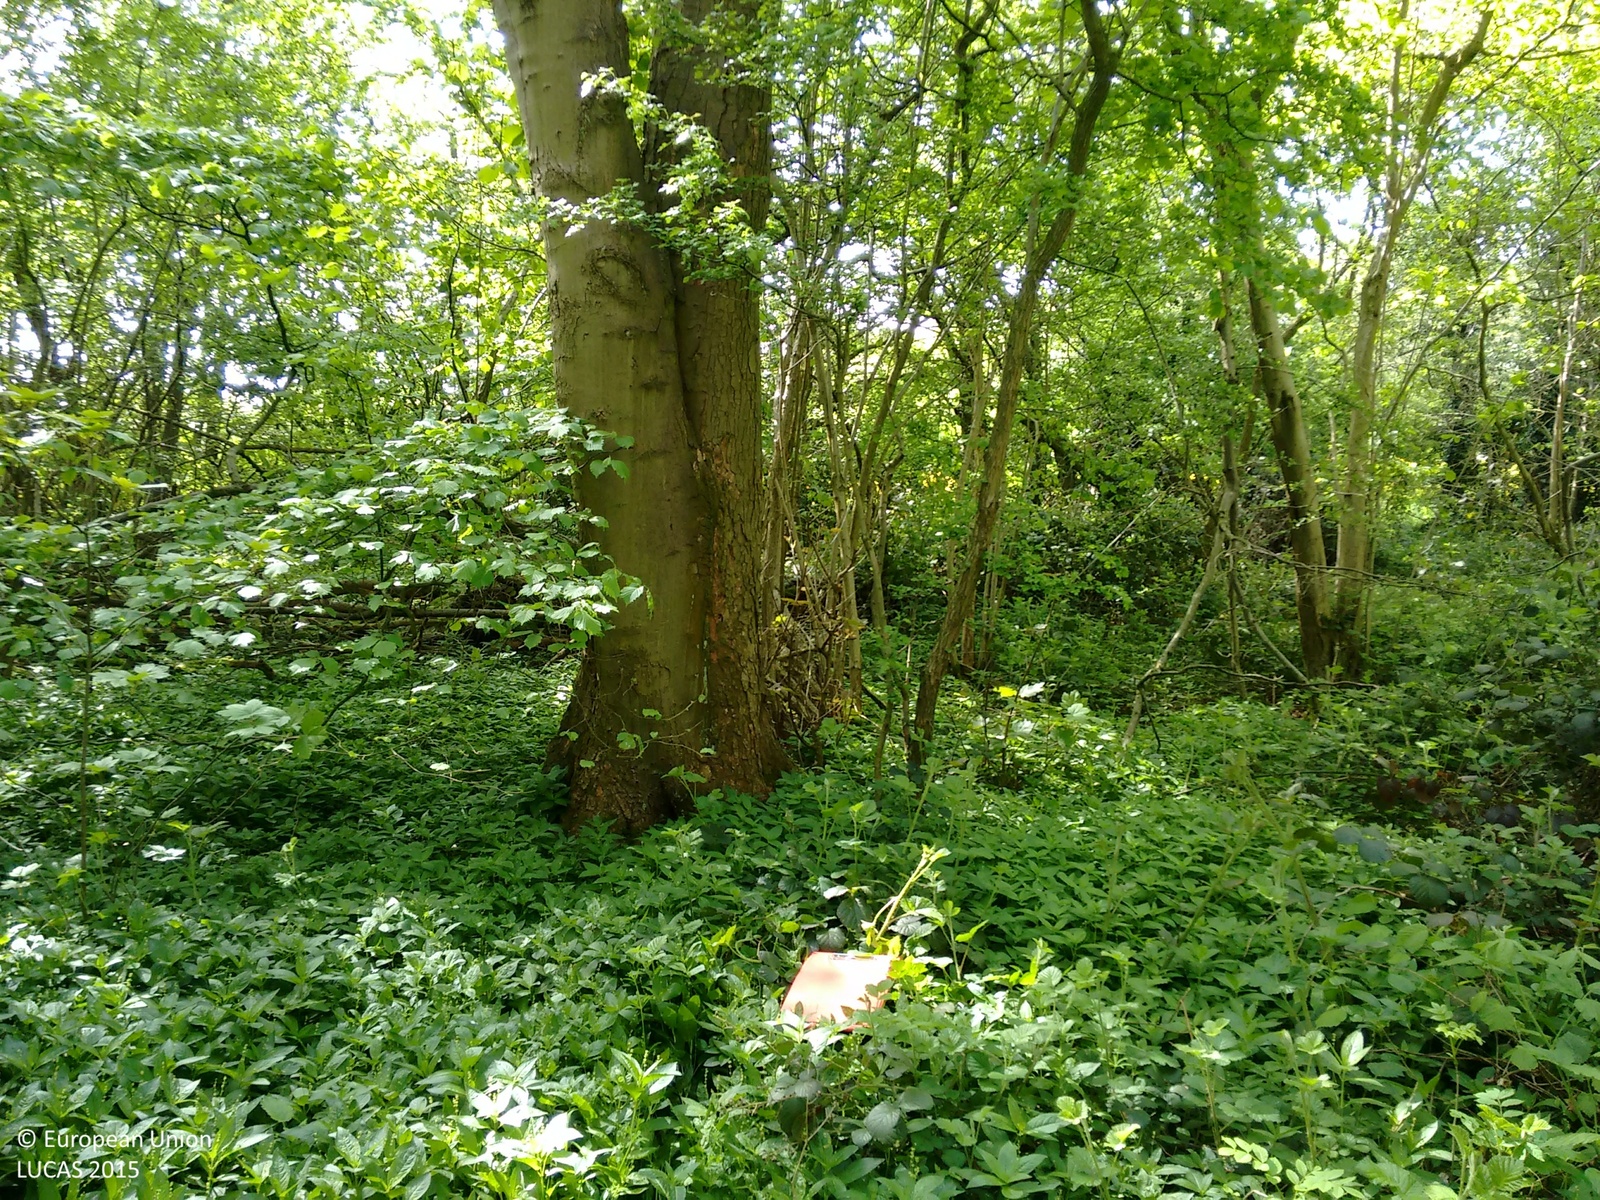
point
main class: Woodland
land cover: Broadleaved woodland
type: mesophytic deciduous forest
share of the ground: > 75 %
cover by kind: broadleaved forest trees 75 %, herbaceous plants 25 %
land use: Semi-natural and natural areas not in use
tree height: > 5 m
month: May
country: GB
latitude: 51.8429
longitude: -0.4449
